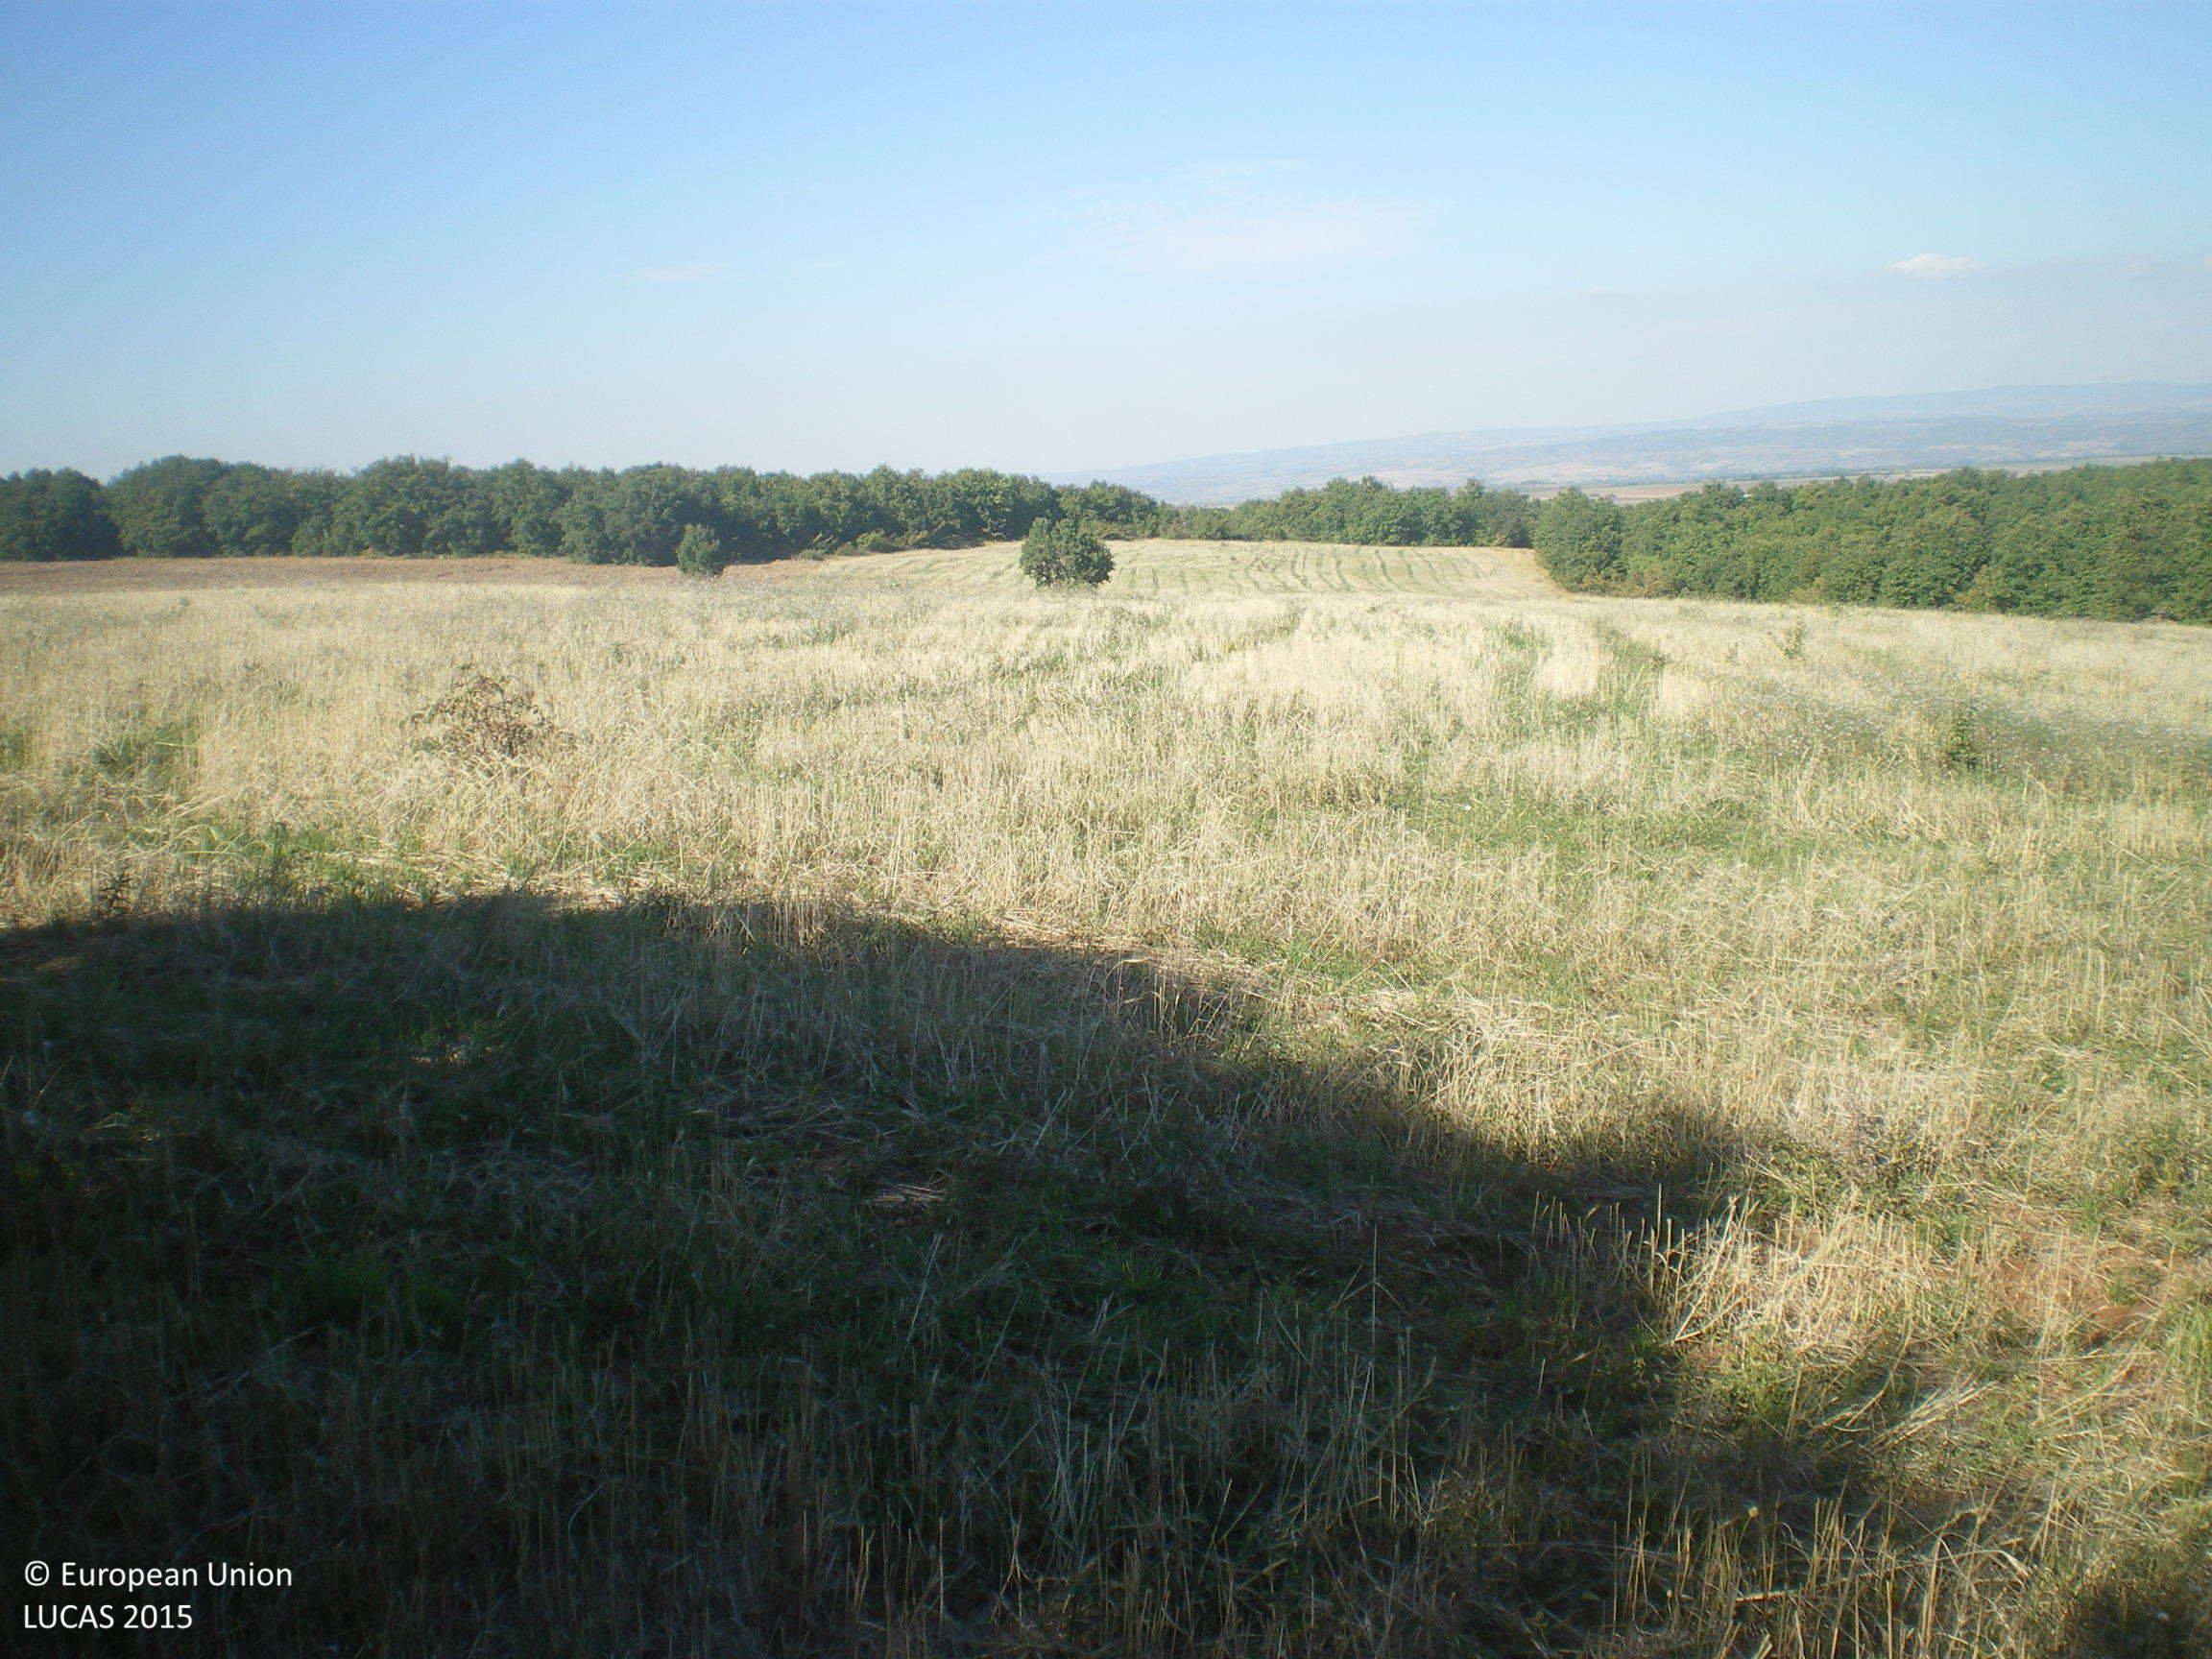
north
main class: Cropland
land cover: Common wheat
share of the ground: < 10 %
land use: Agriculture (excluding fallow land and kitchen gardens)
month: September
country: BG
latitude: 41.8138
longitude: 25.9979
